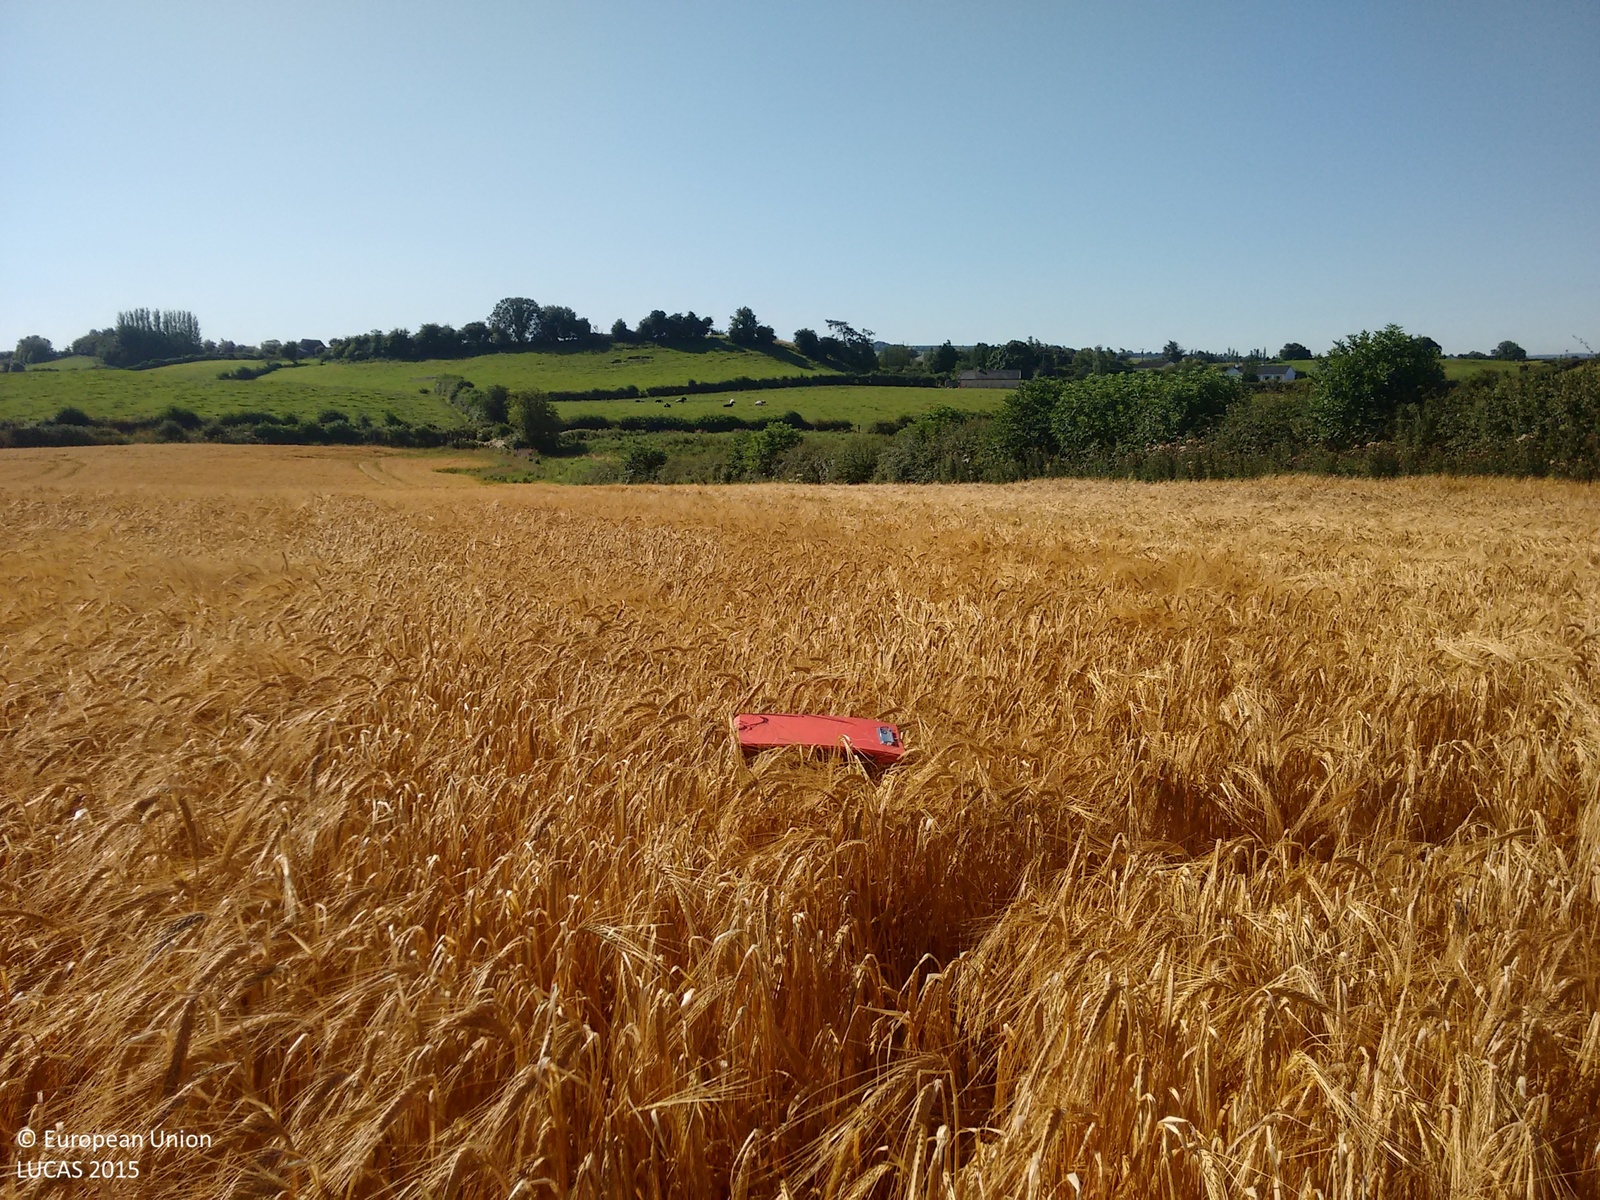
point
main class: Cropland
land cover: Barley
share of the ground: > 75 %
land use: Agriculture (excluding fallow land and kitchen gardens)
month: August
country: IE
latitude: 52.9687
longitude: -7.8137
